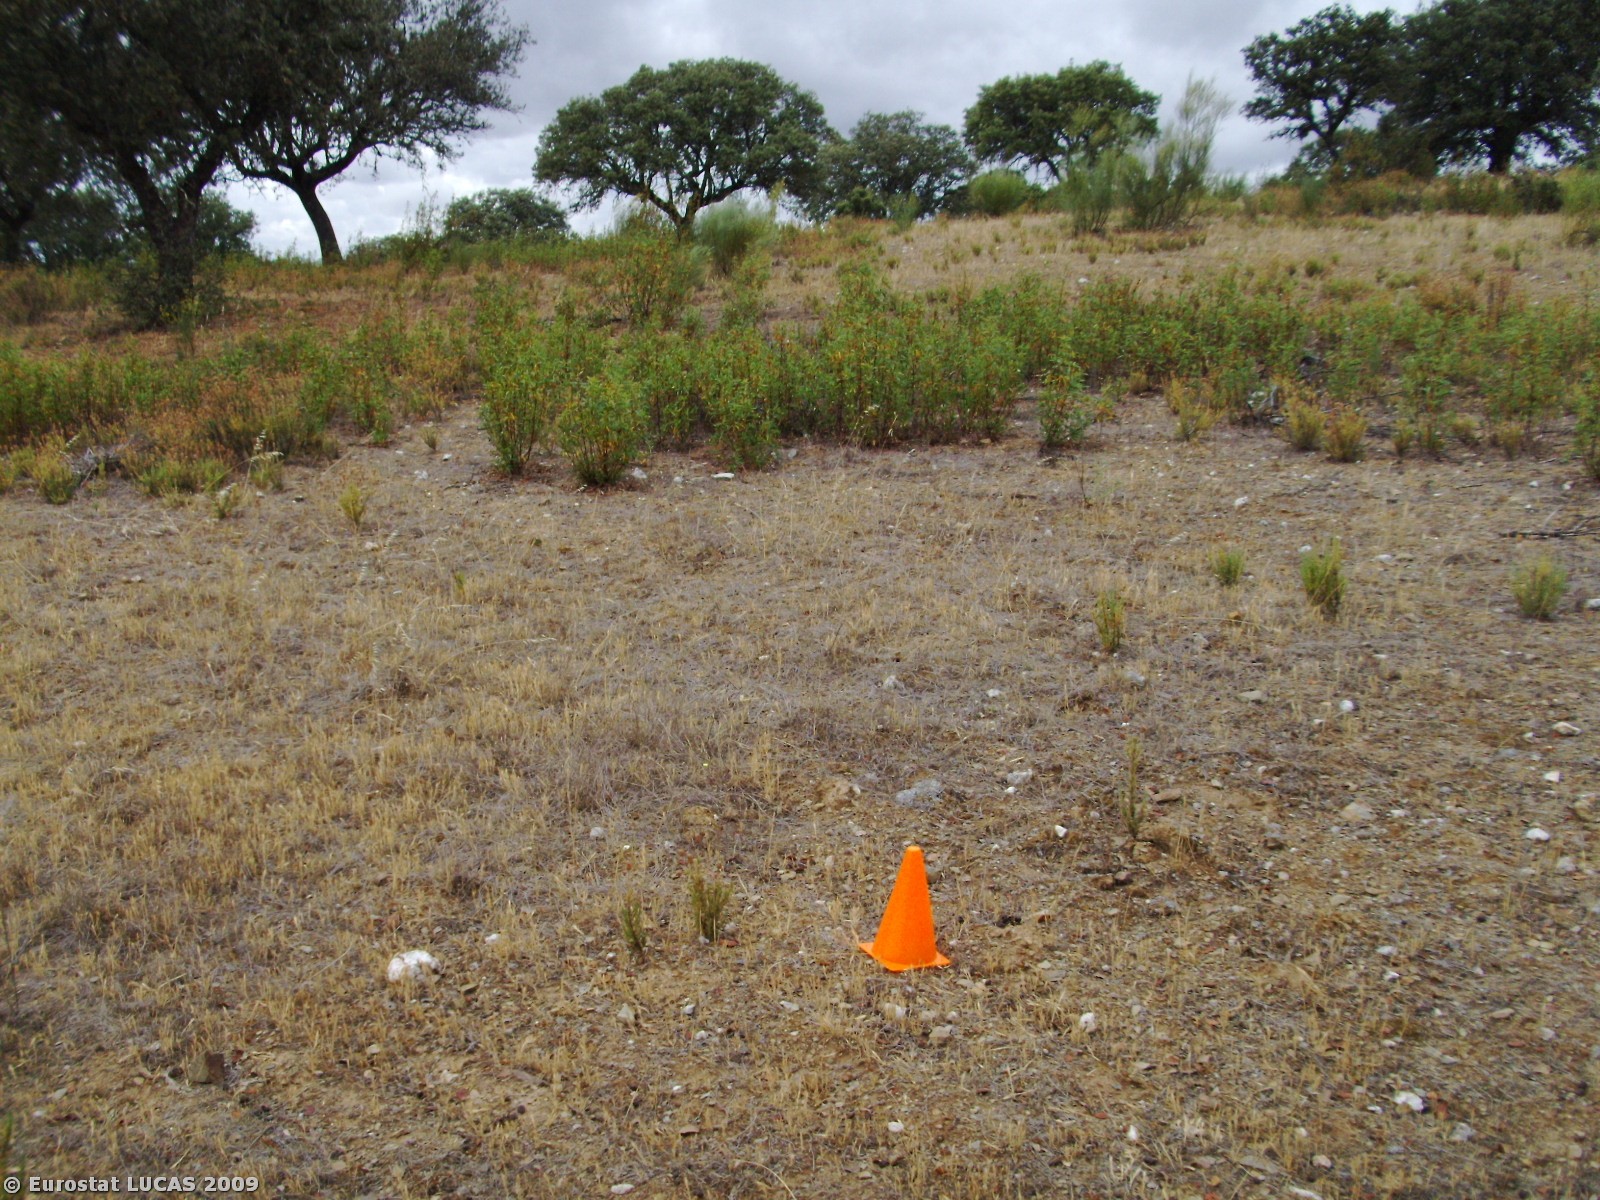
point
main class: Woodland
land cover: Broadleaved woodland
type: broadleaved evergreen forest
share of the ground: 25 - 50 %
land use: Forestry
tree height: > 5 m
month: June
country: PT
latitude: 39.7020
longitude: -7.0559
